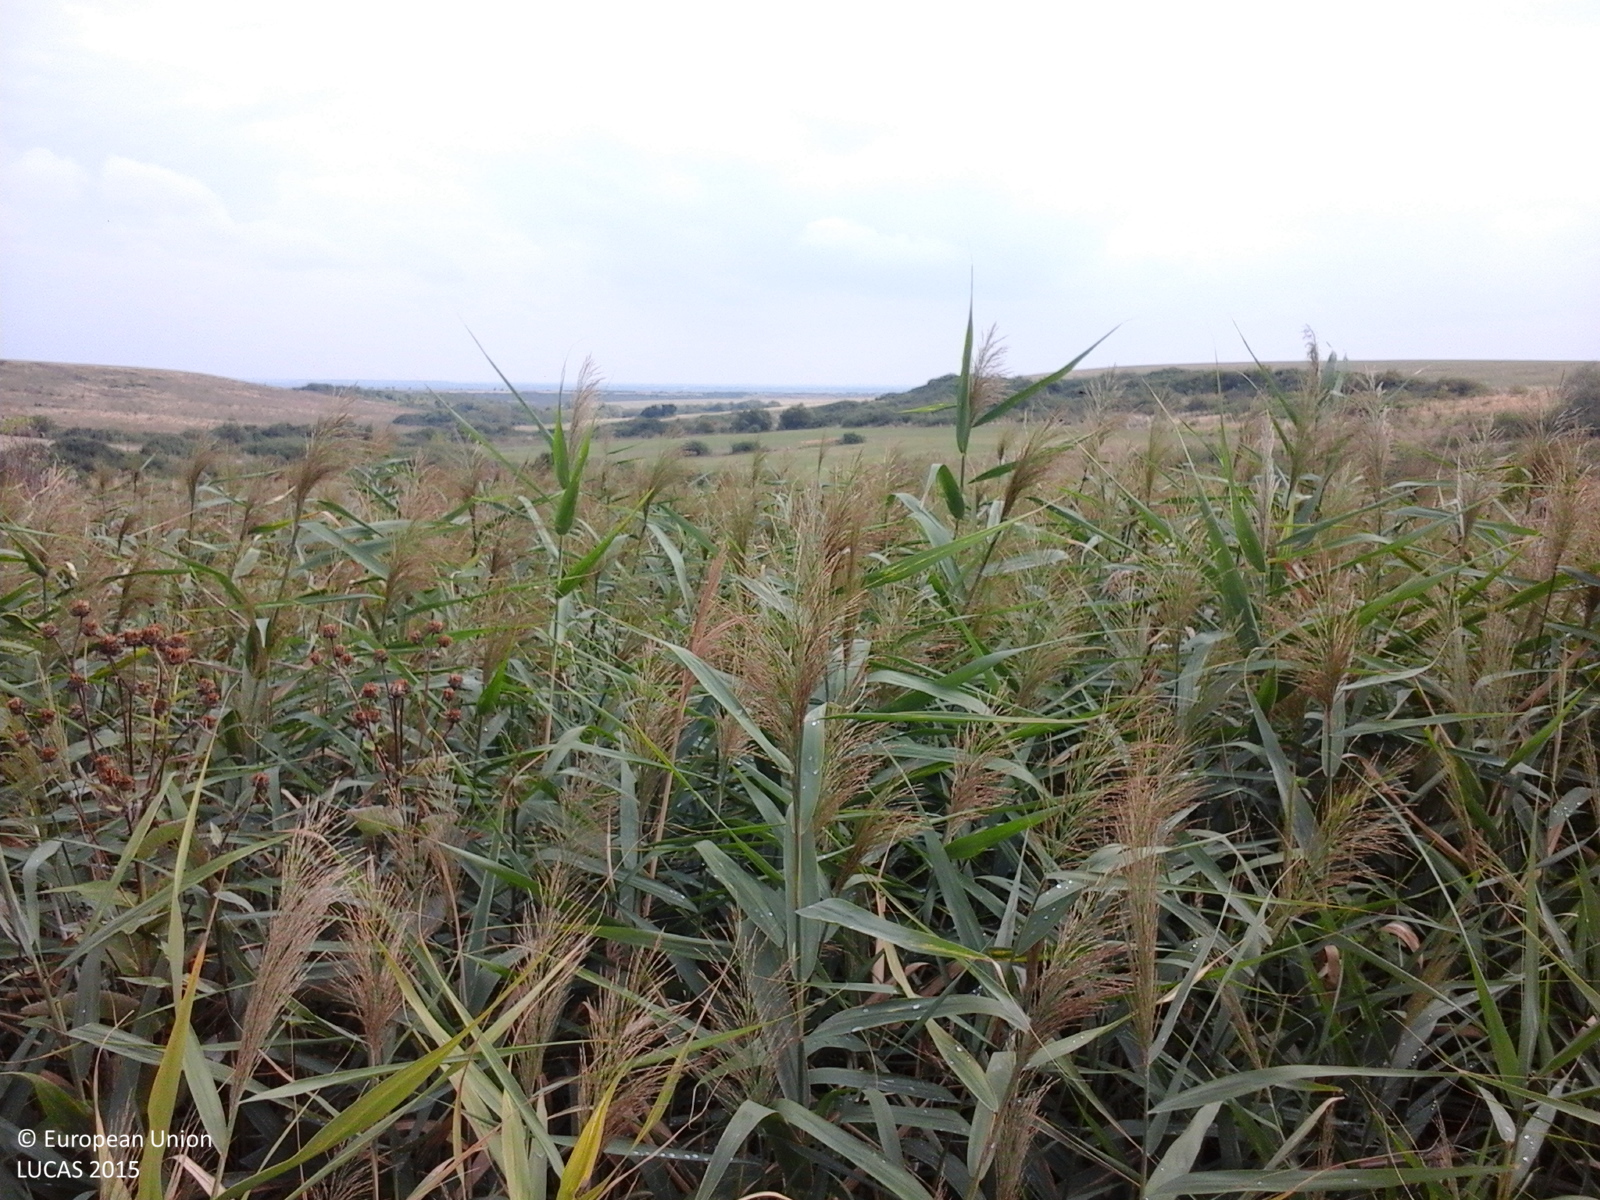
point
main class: Grassland
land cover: Spontaneously vegetated surfaces
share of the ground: > 75 %
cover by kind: herbaceous plants 100 %
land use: Semi-natural and natural areas not in use
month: August
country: RO
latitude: 45.8688
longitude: 21.3820
